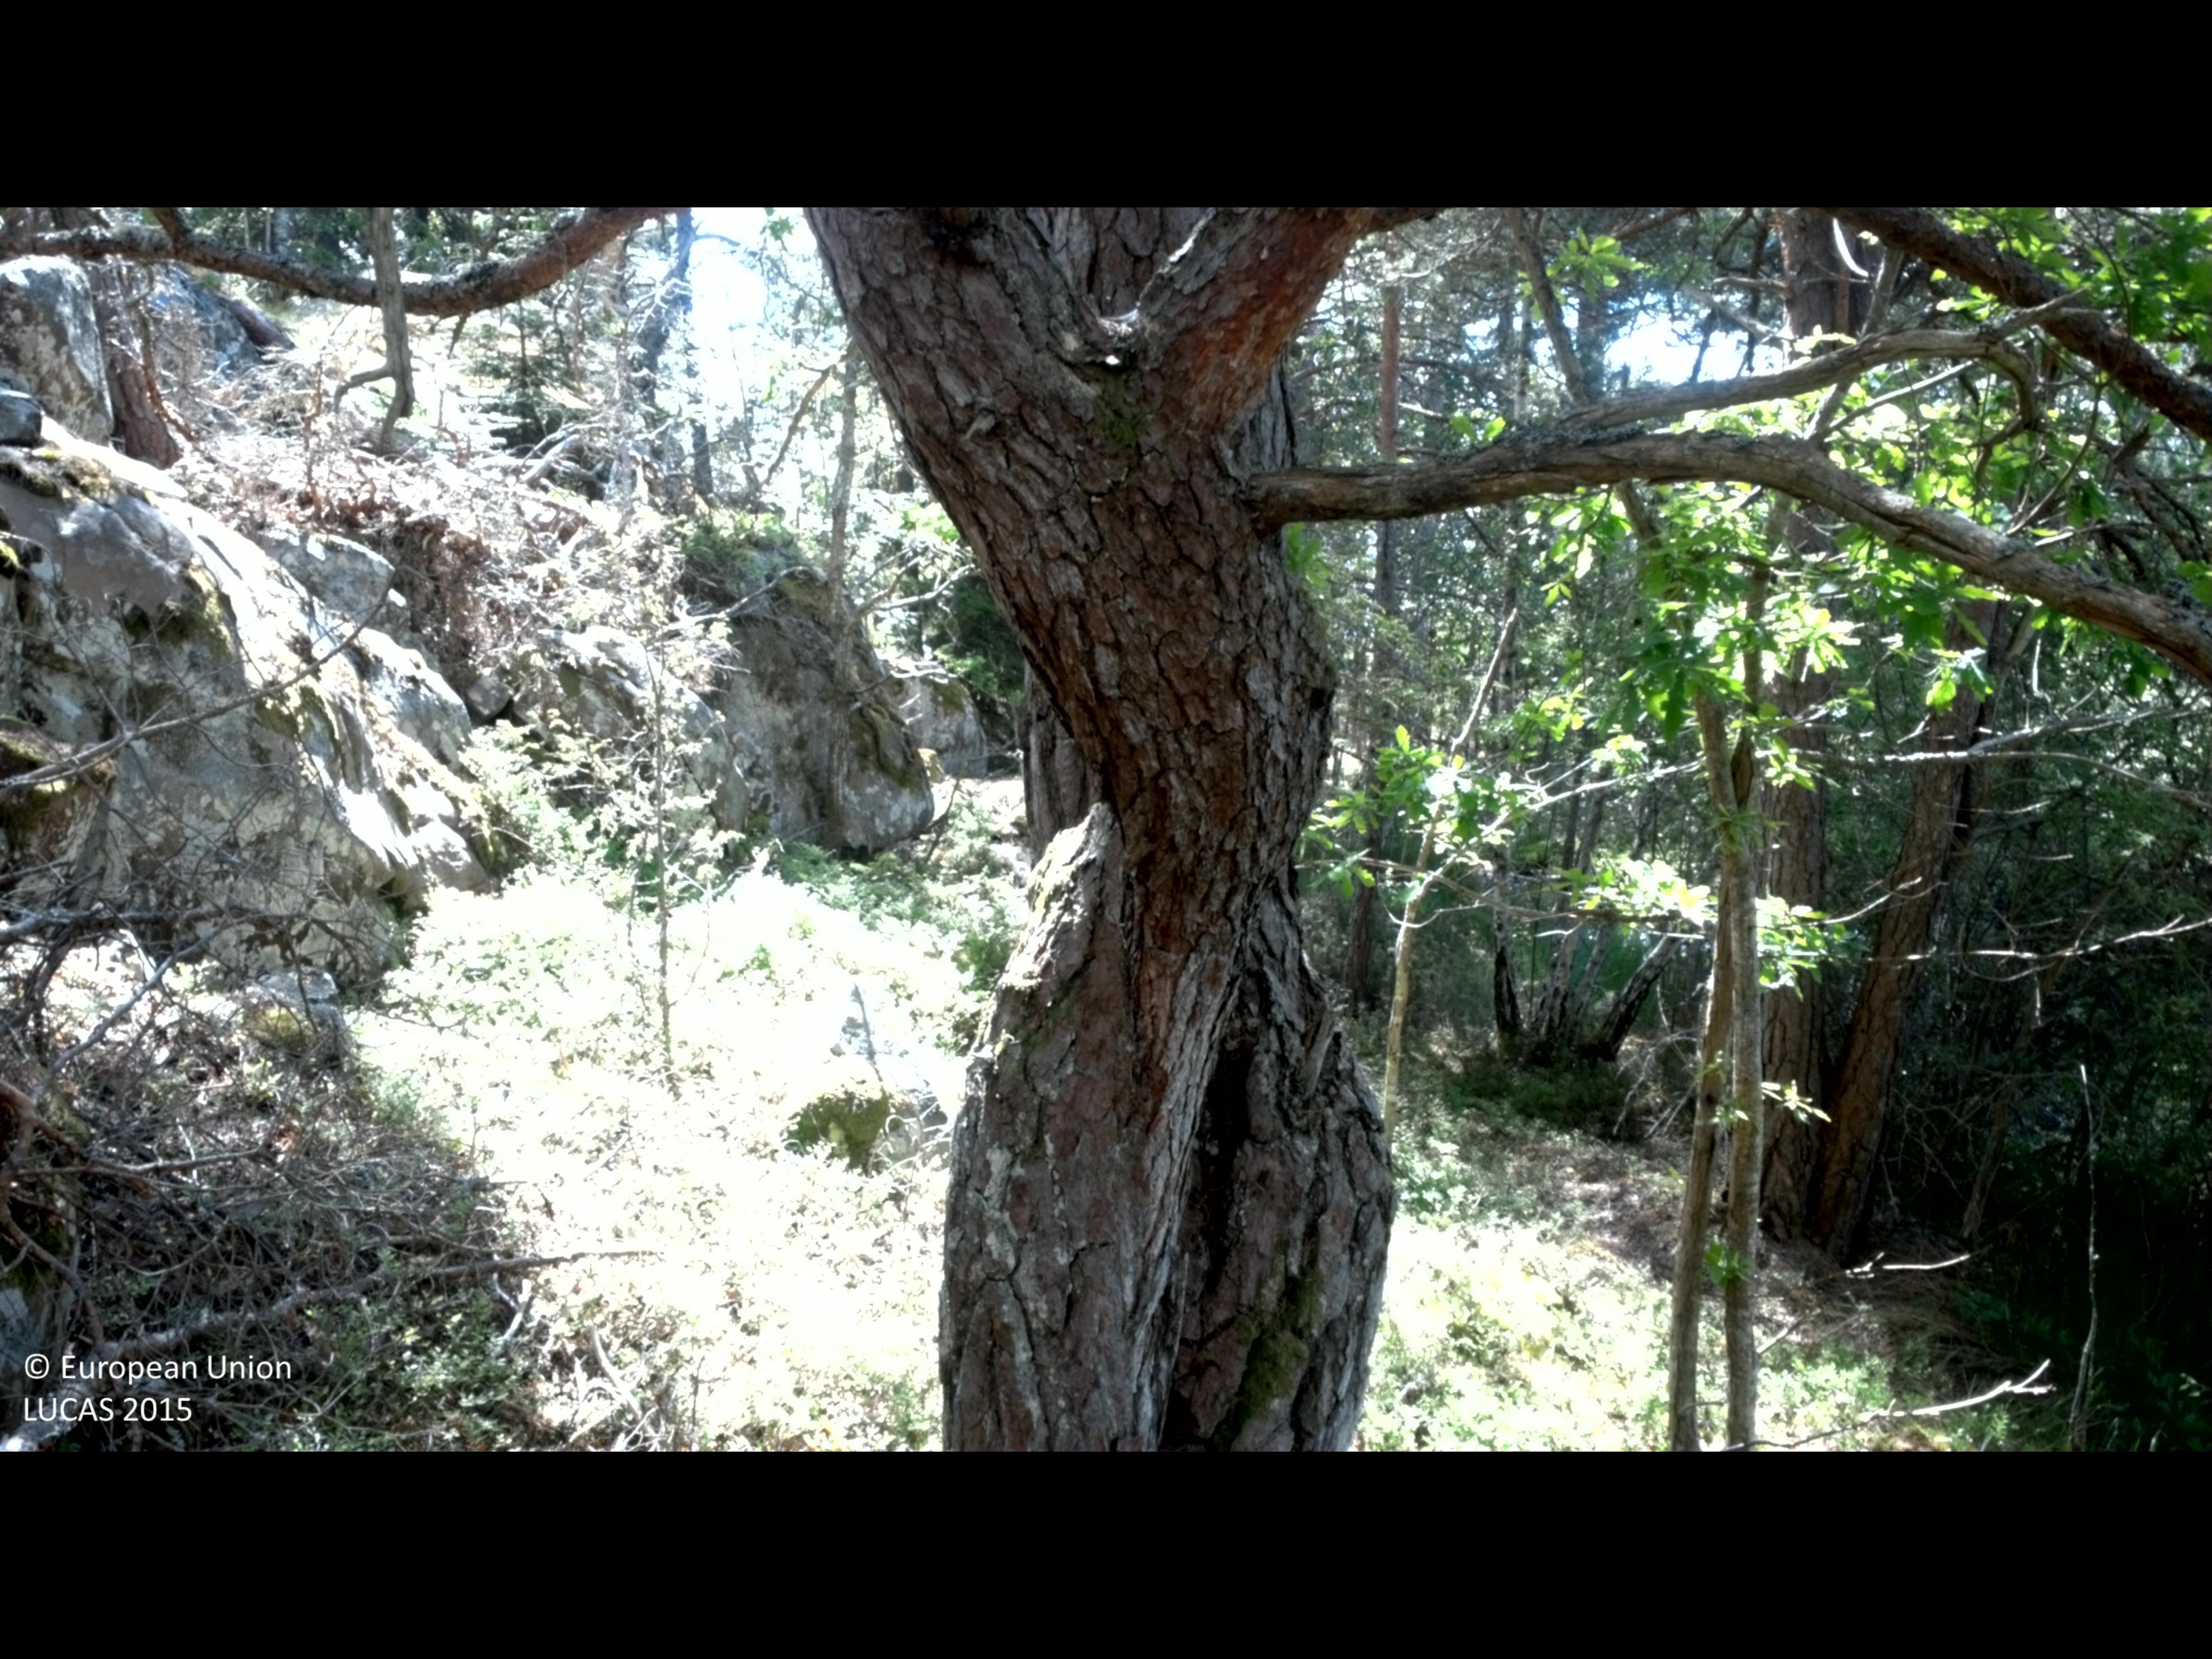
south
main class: Woodland
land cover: Pine dominated coniferous woodland
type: hemiboreal forest and nemoral coniferous forest and mixed broadleaved-coniferous forest
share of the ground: 50 - 75 %
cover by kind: coniferous forest trees 55 %, broadleaved forest trees 15 %, consolidated bare surface 15 %, lichens and mosses 10 %, shrubs 5 %
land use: Forestry
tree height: > 5 m
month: June
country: SE
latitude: 57.6950
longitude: 16.6258
